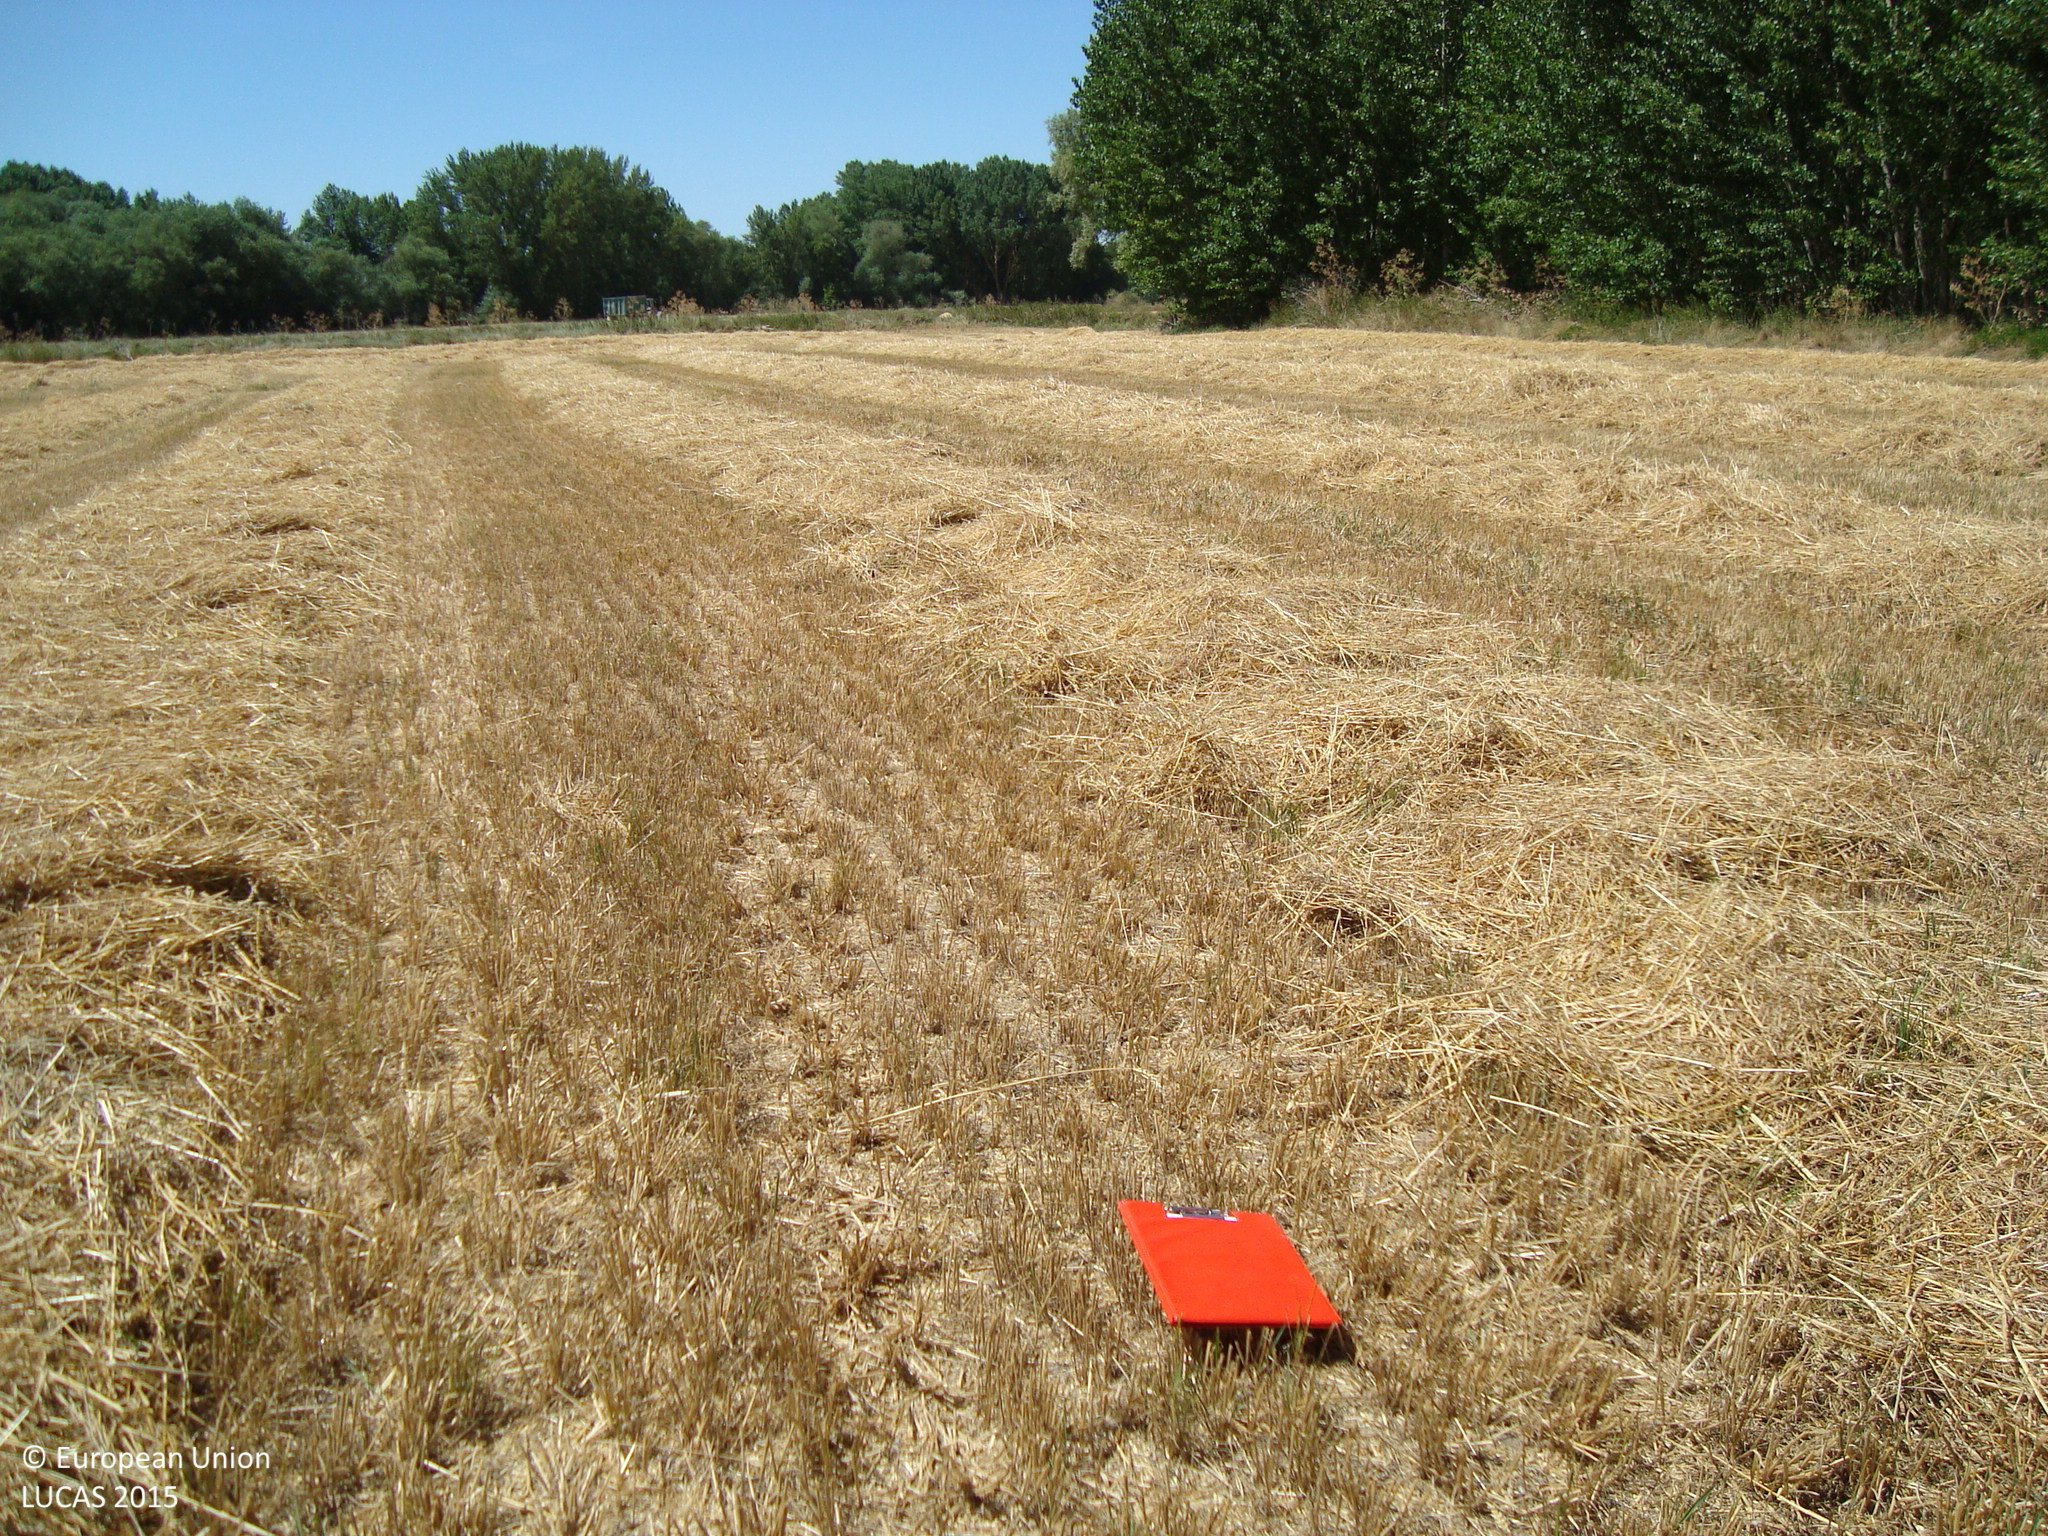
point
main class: Cropland
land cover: Common wheat
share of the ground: < 10 %
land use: Agriculture (excluding fallow land and kitchen gardens)
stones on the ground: < 10 %
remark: Harvested field
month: July
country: ES
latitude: 42.2518
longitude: -3.9415
